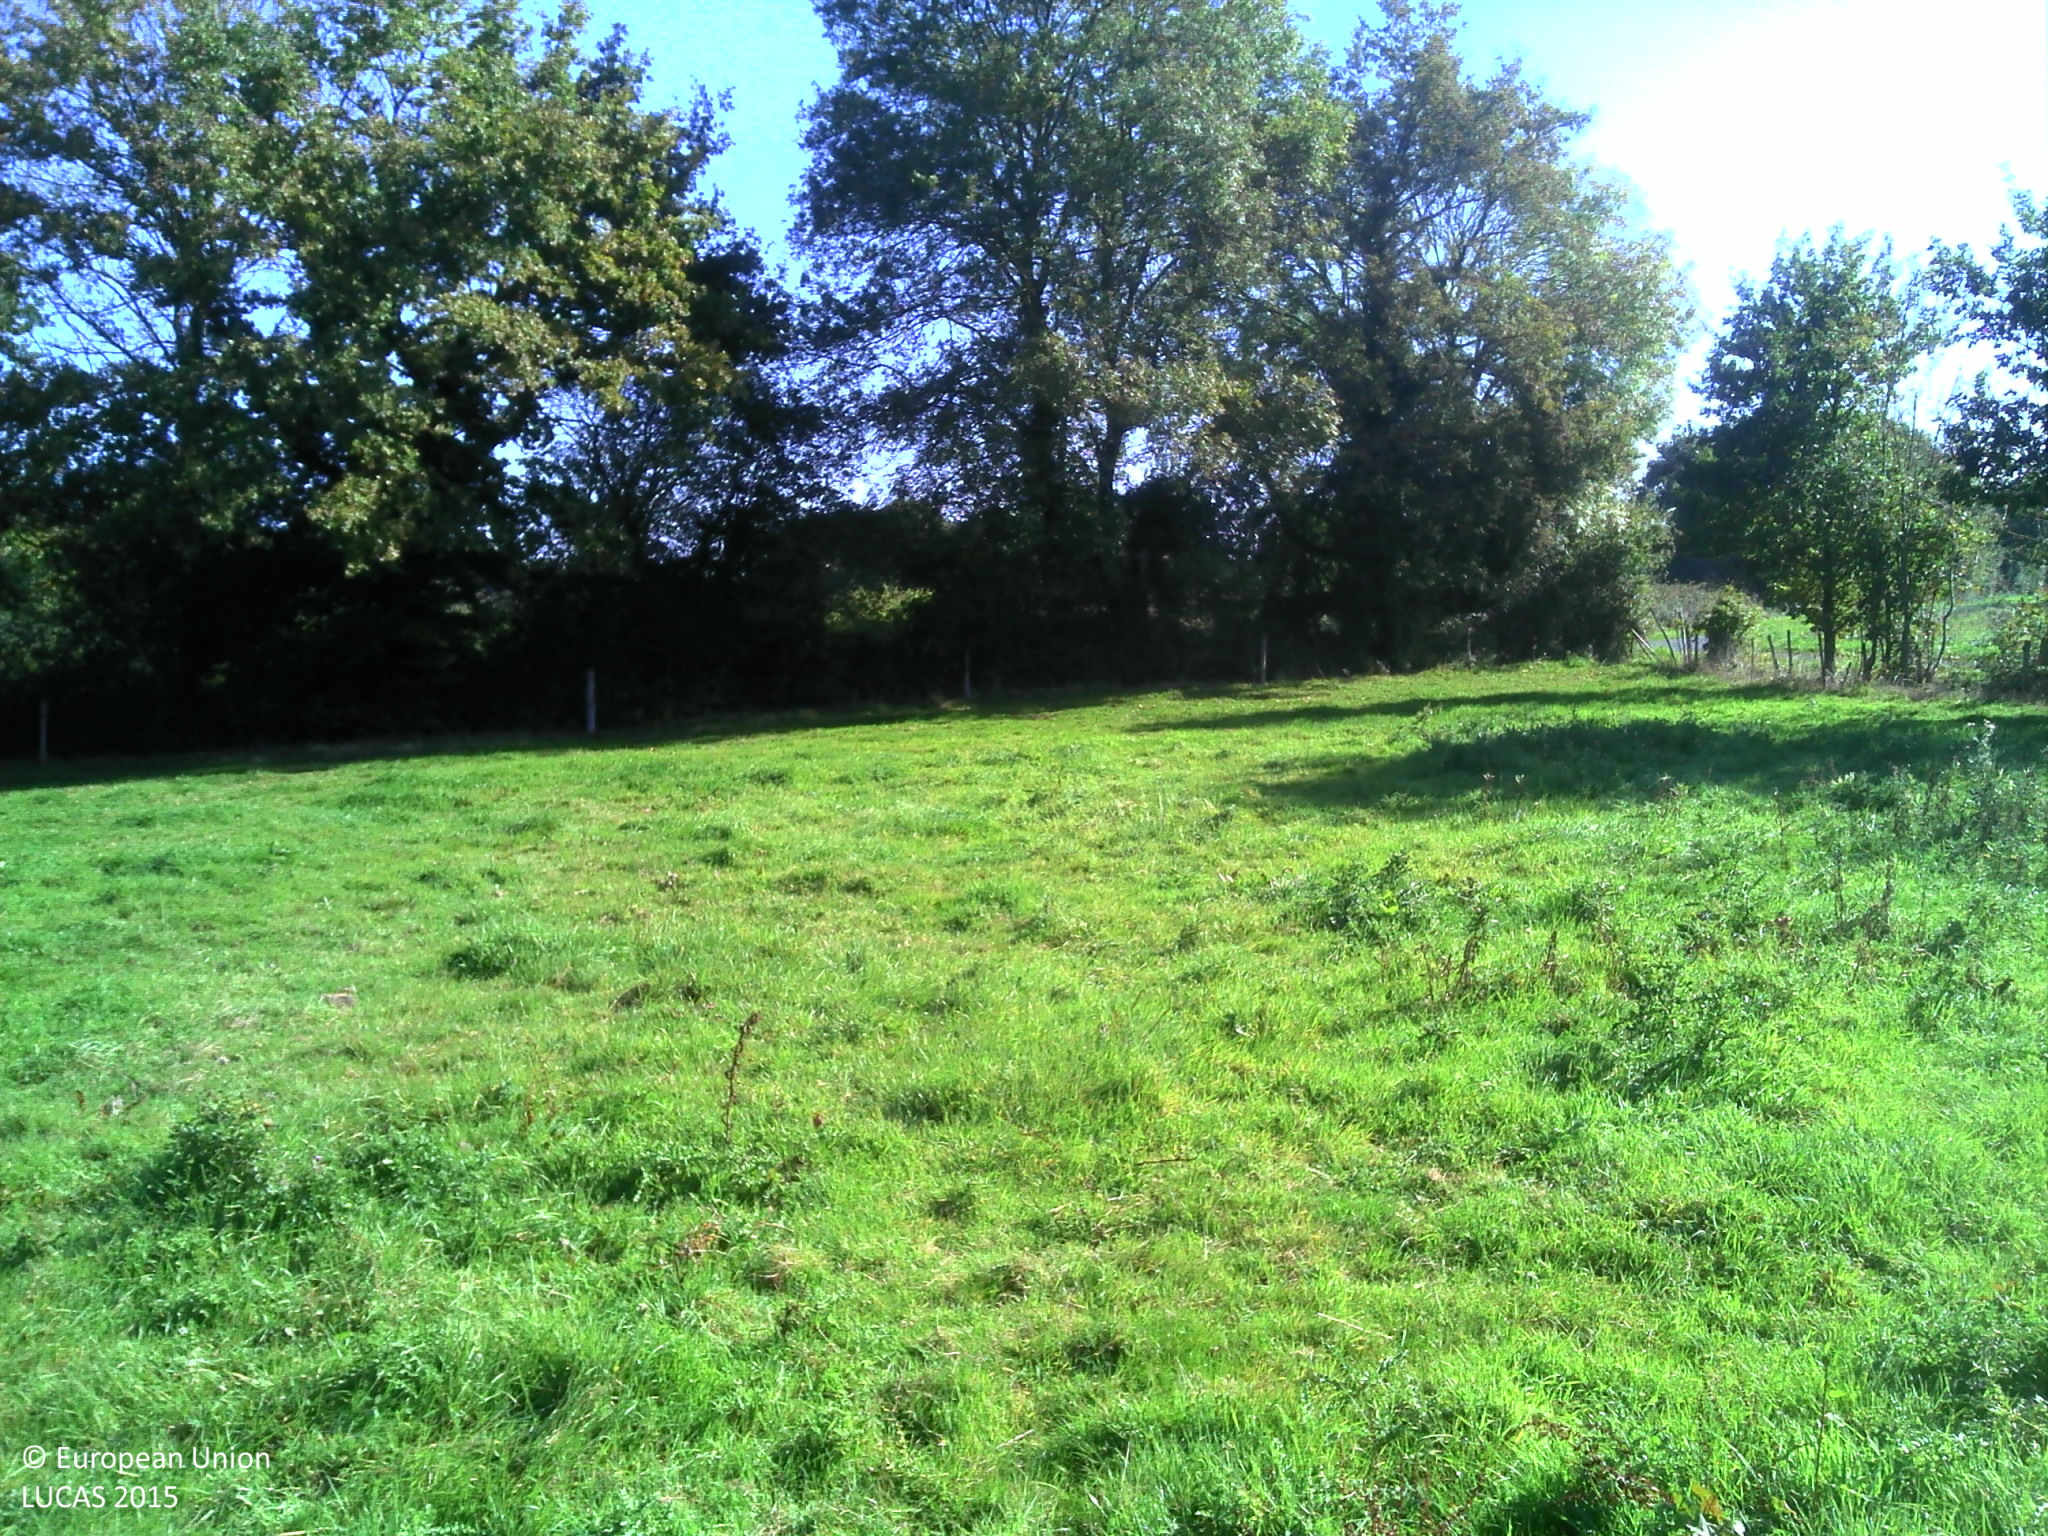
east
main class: Grassland
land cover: Grassland without tree/shrub cover
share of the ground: > 75 %
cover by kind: herbaceous plants 100 %
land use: Agriculture (excluding fallow land and kitchen gardens)
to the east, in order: Grassland without tree/shrub cover; Fences; Broadleaved woodland; Ditches and canals; Broadleaved woodland; Spontaneously vegetated surfaces; Grassland without tree/shrub cover; Fences; Grass margins; Fences; Temporary grasslands; Fences; Broadleaved woodland; Fences; Grassland without tree/shrub cover
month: October
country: FR
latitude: 46.8421
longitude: -1.4602
